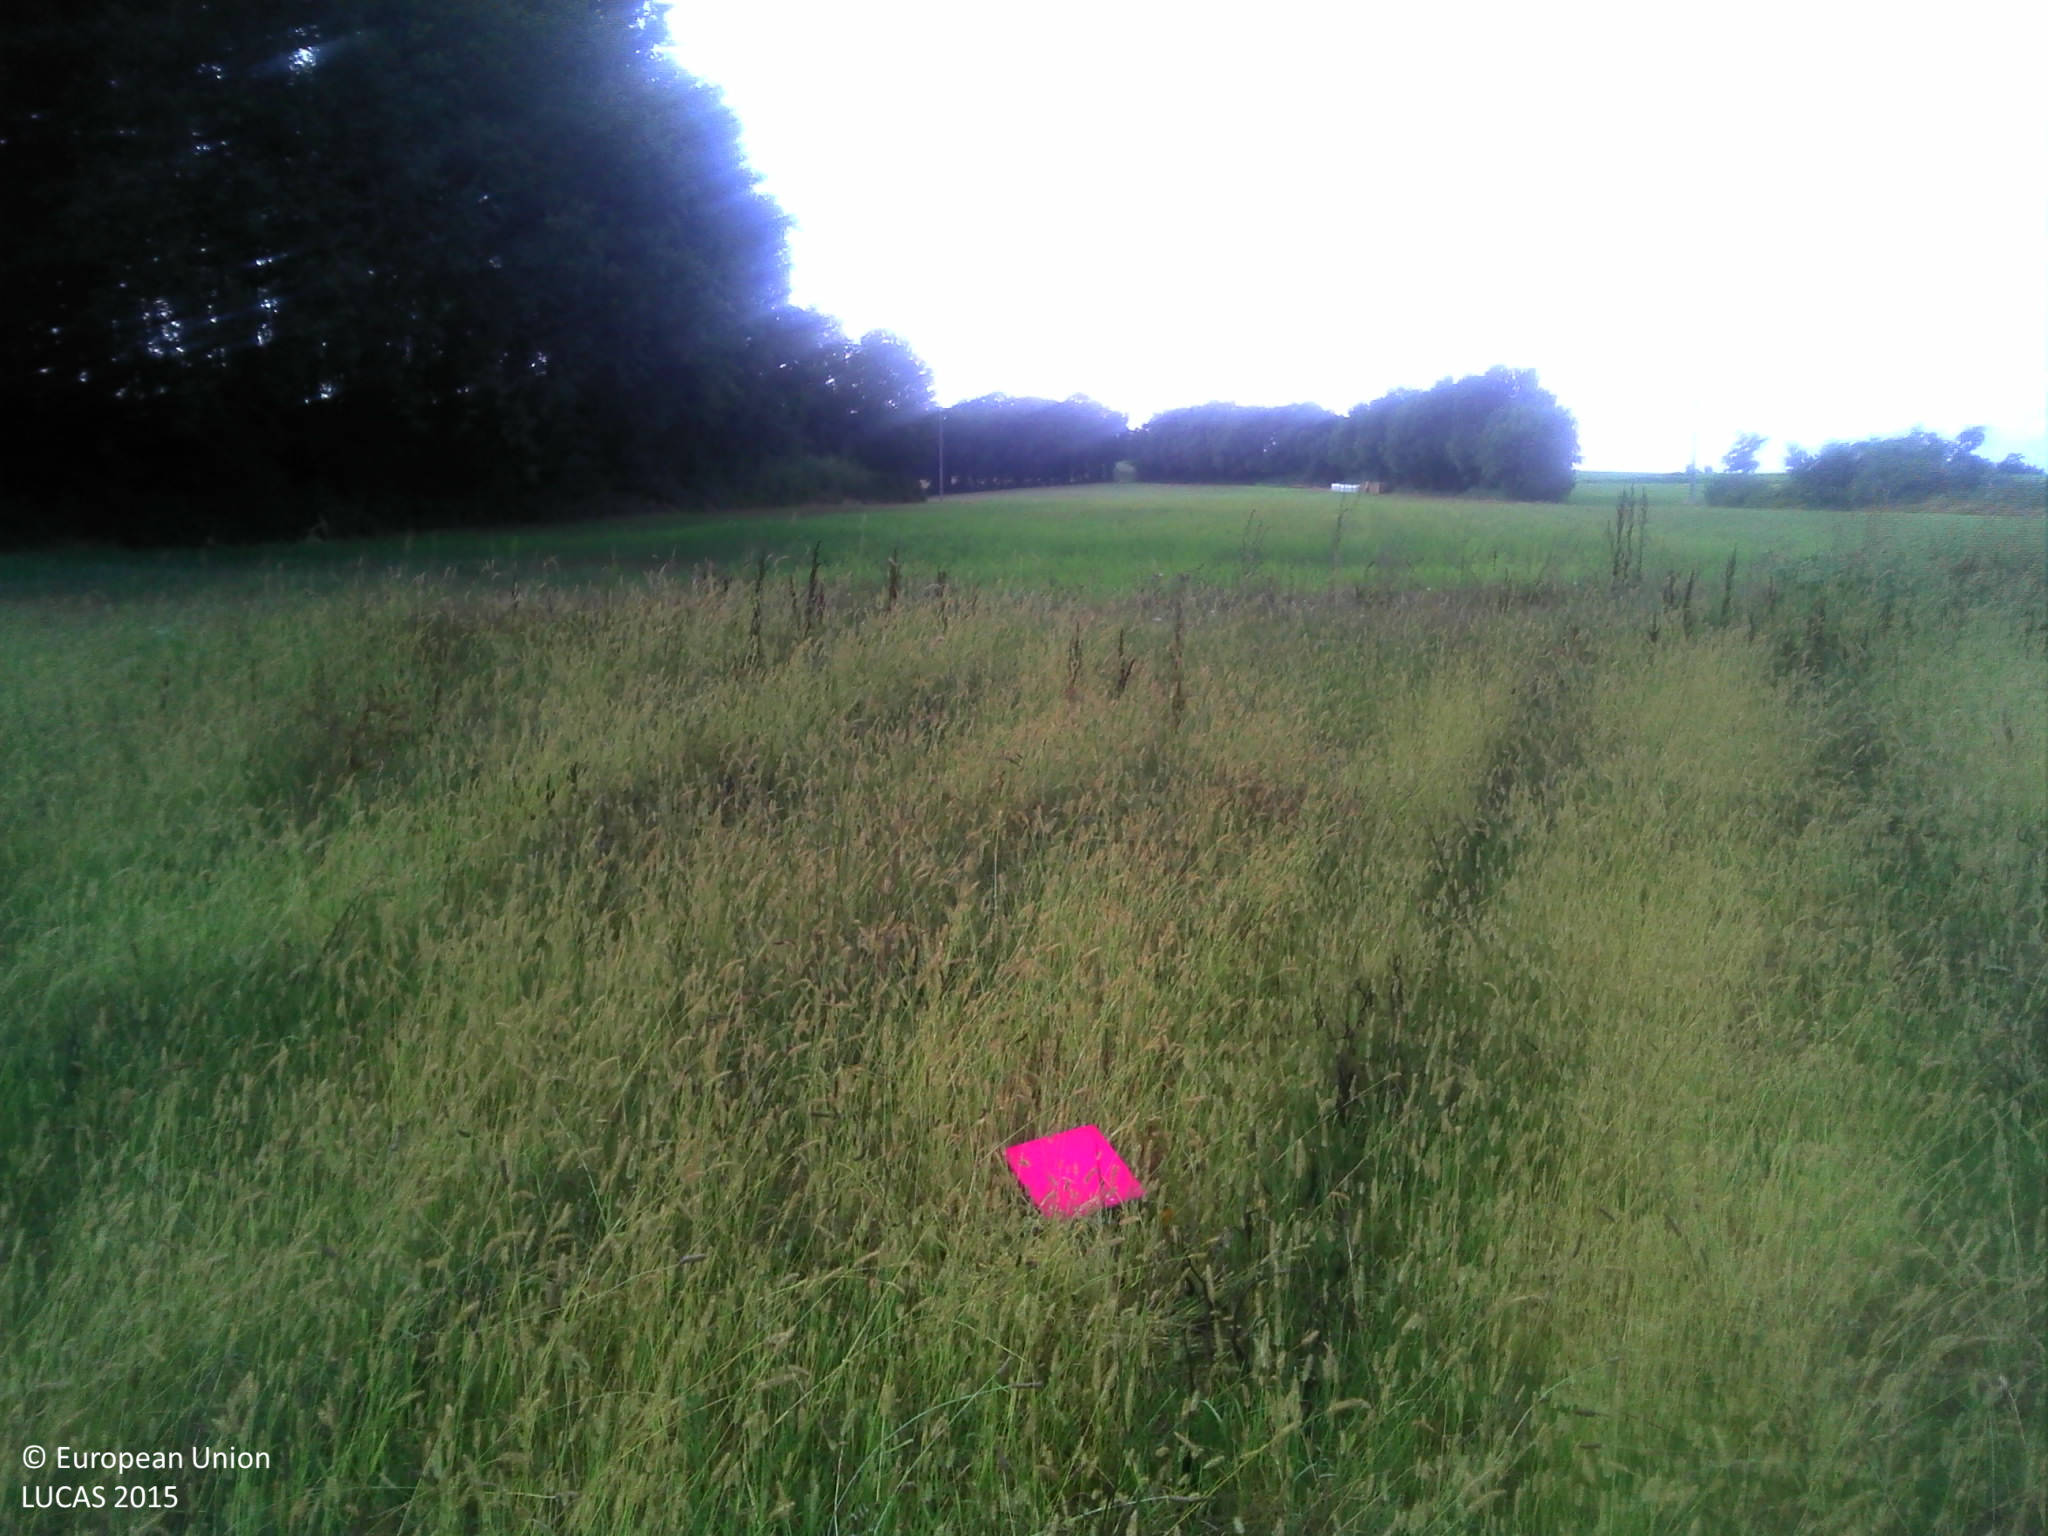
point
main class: Grassland
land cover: Spontaneously vegetated surfaces
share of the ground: > 75 %
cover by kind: herbaceous plants 100 %
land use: Fallow land
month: July
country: FR
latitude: 44.0521
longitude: 0.6217
